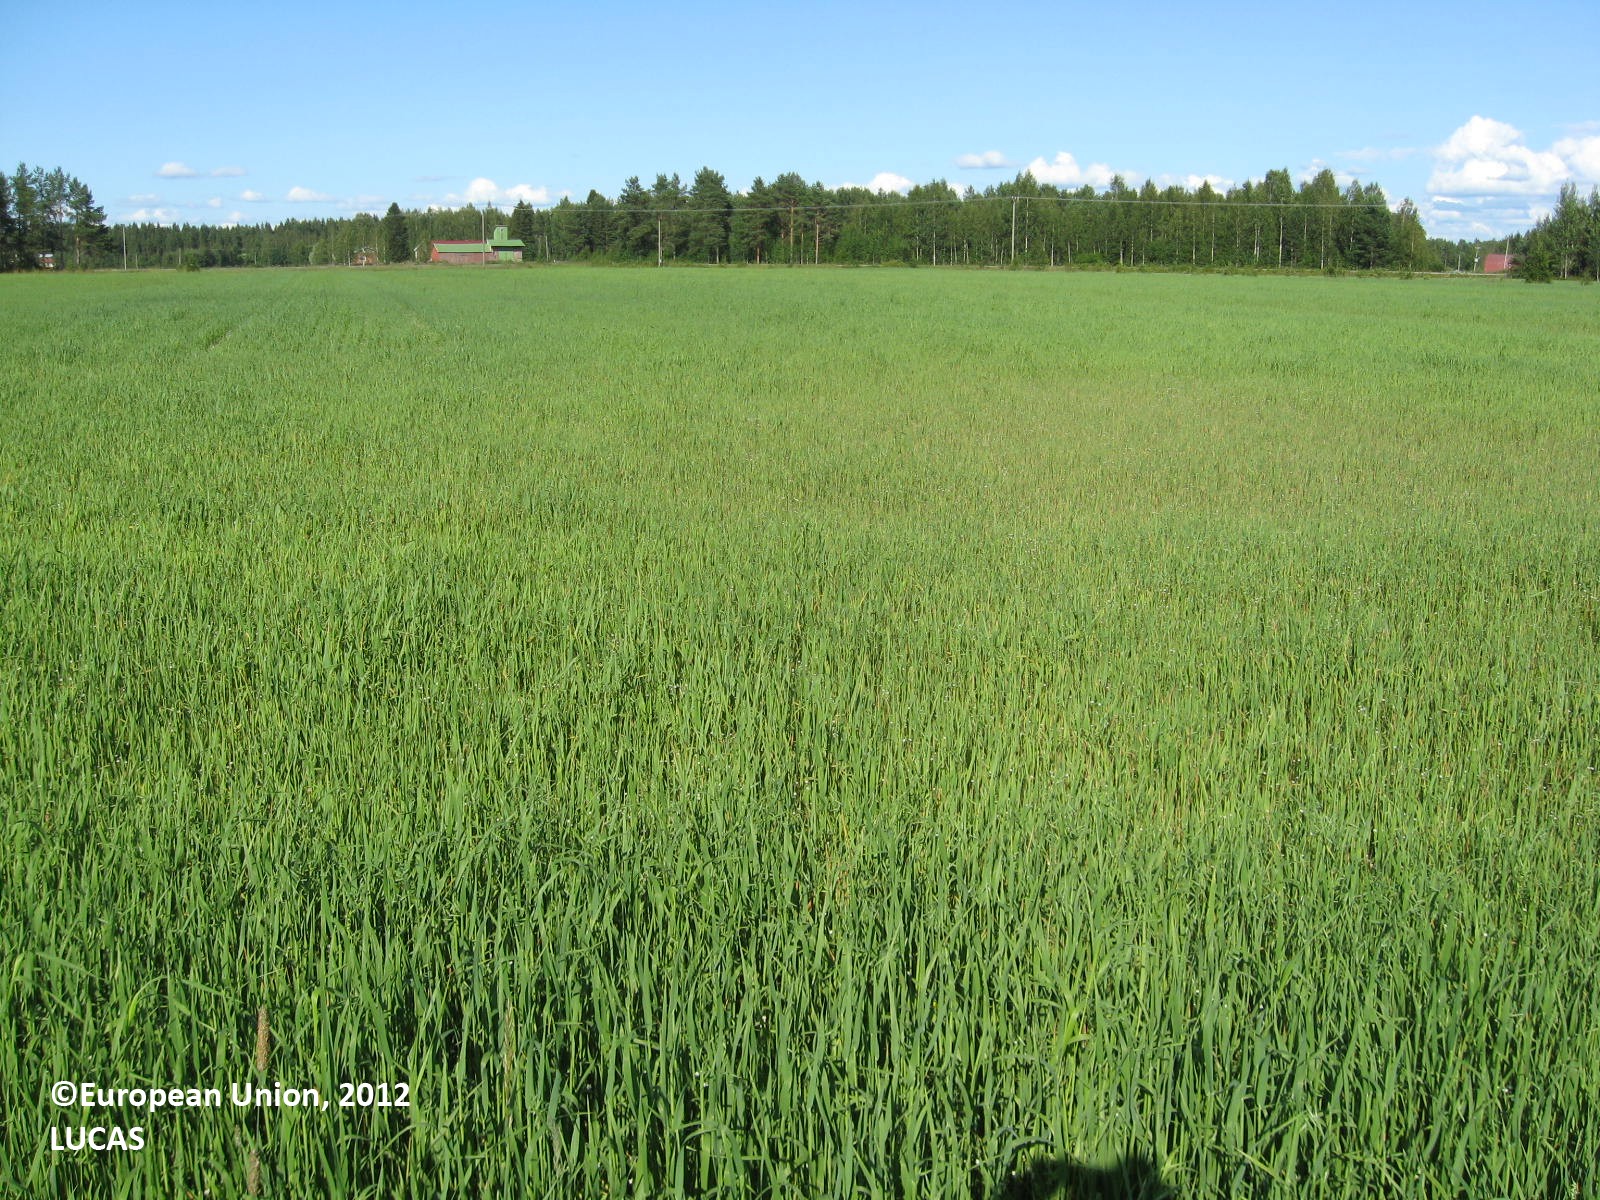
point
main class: Cropland
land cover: Oats
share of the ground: > 75 %
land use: Agriculture (excluding fallow land and kitchen gardens)
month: July
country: FI
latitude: 62.0516
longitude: 22.5105
